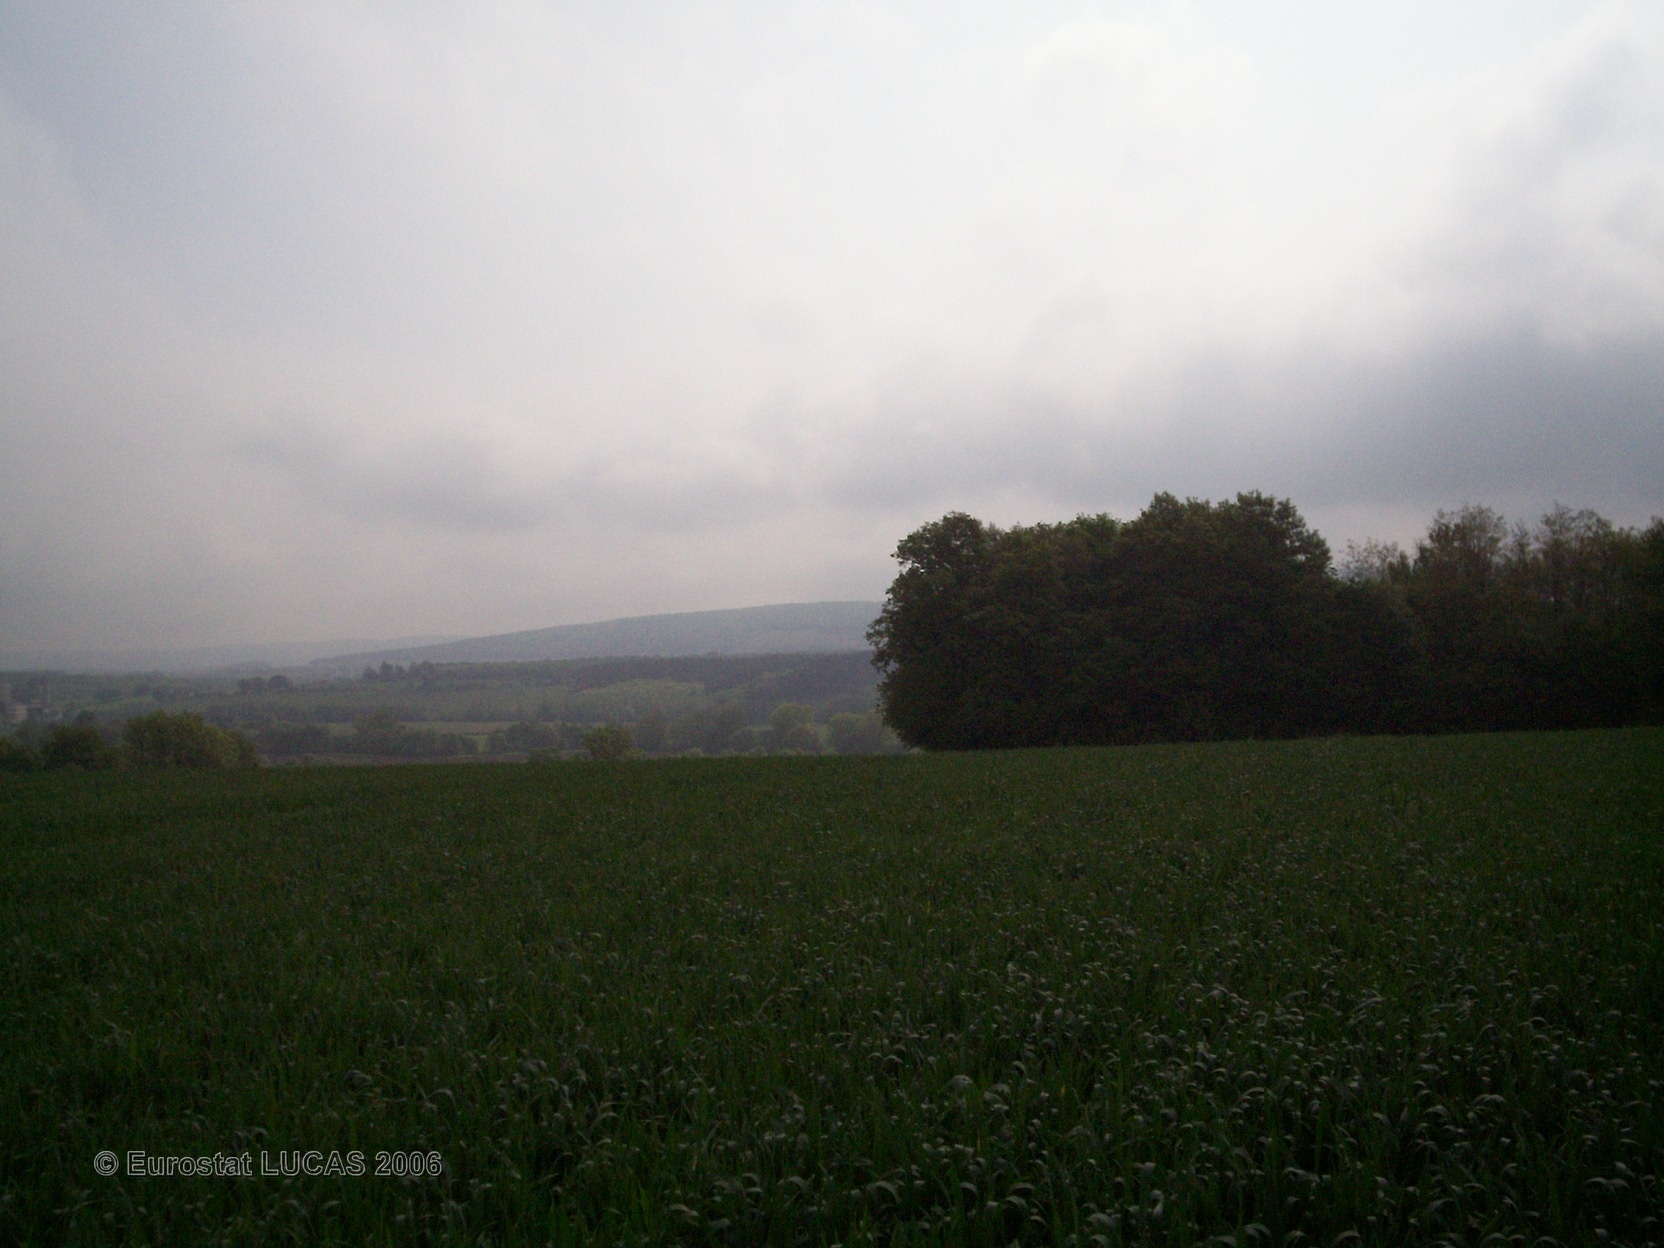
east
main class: Cropland
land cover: Common wheat
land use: Agriculture (excluding fallow land and kitchen gardens)
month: May
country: FR
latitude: 46.5072
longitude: 4.6715
